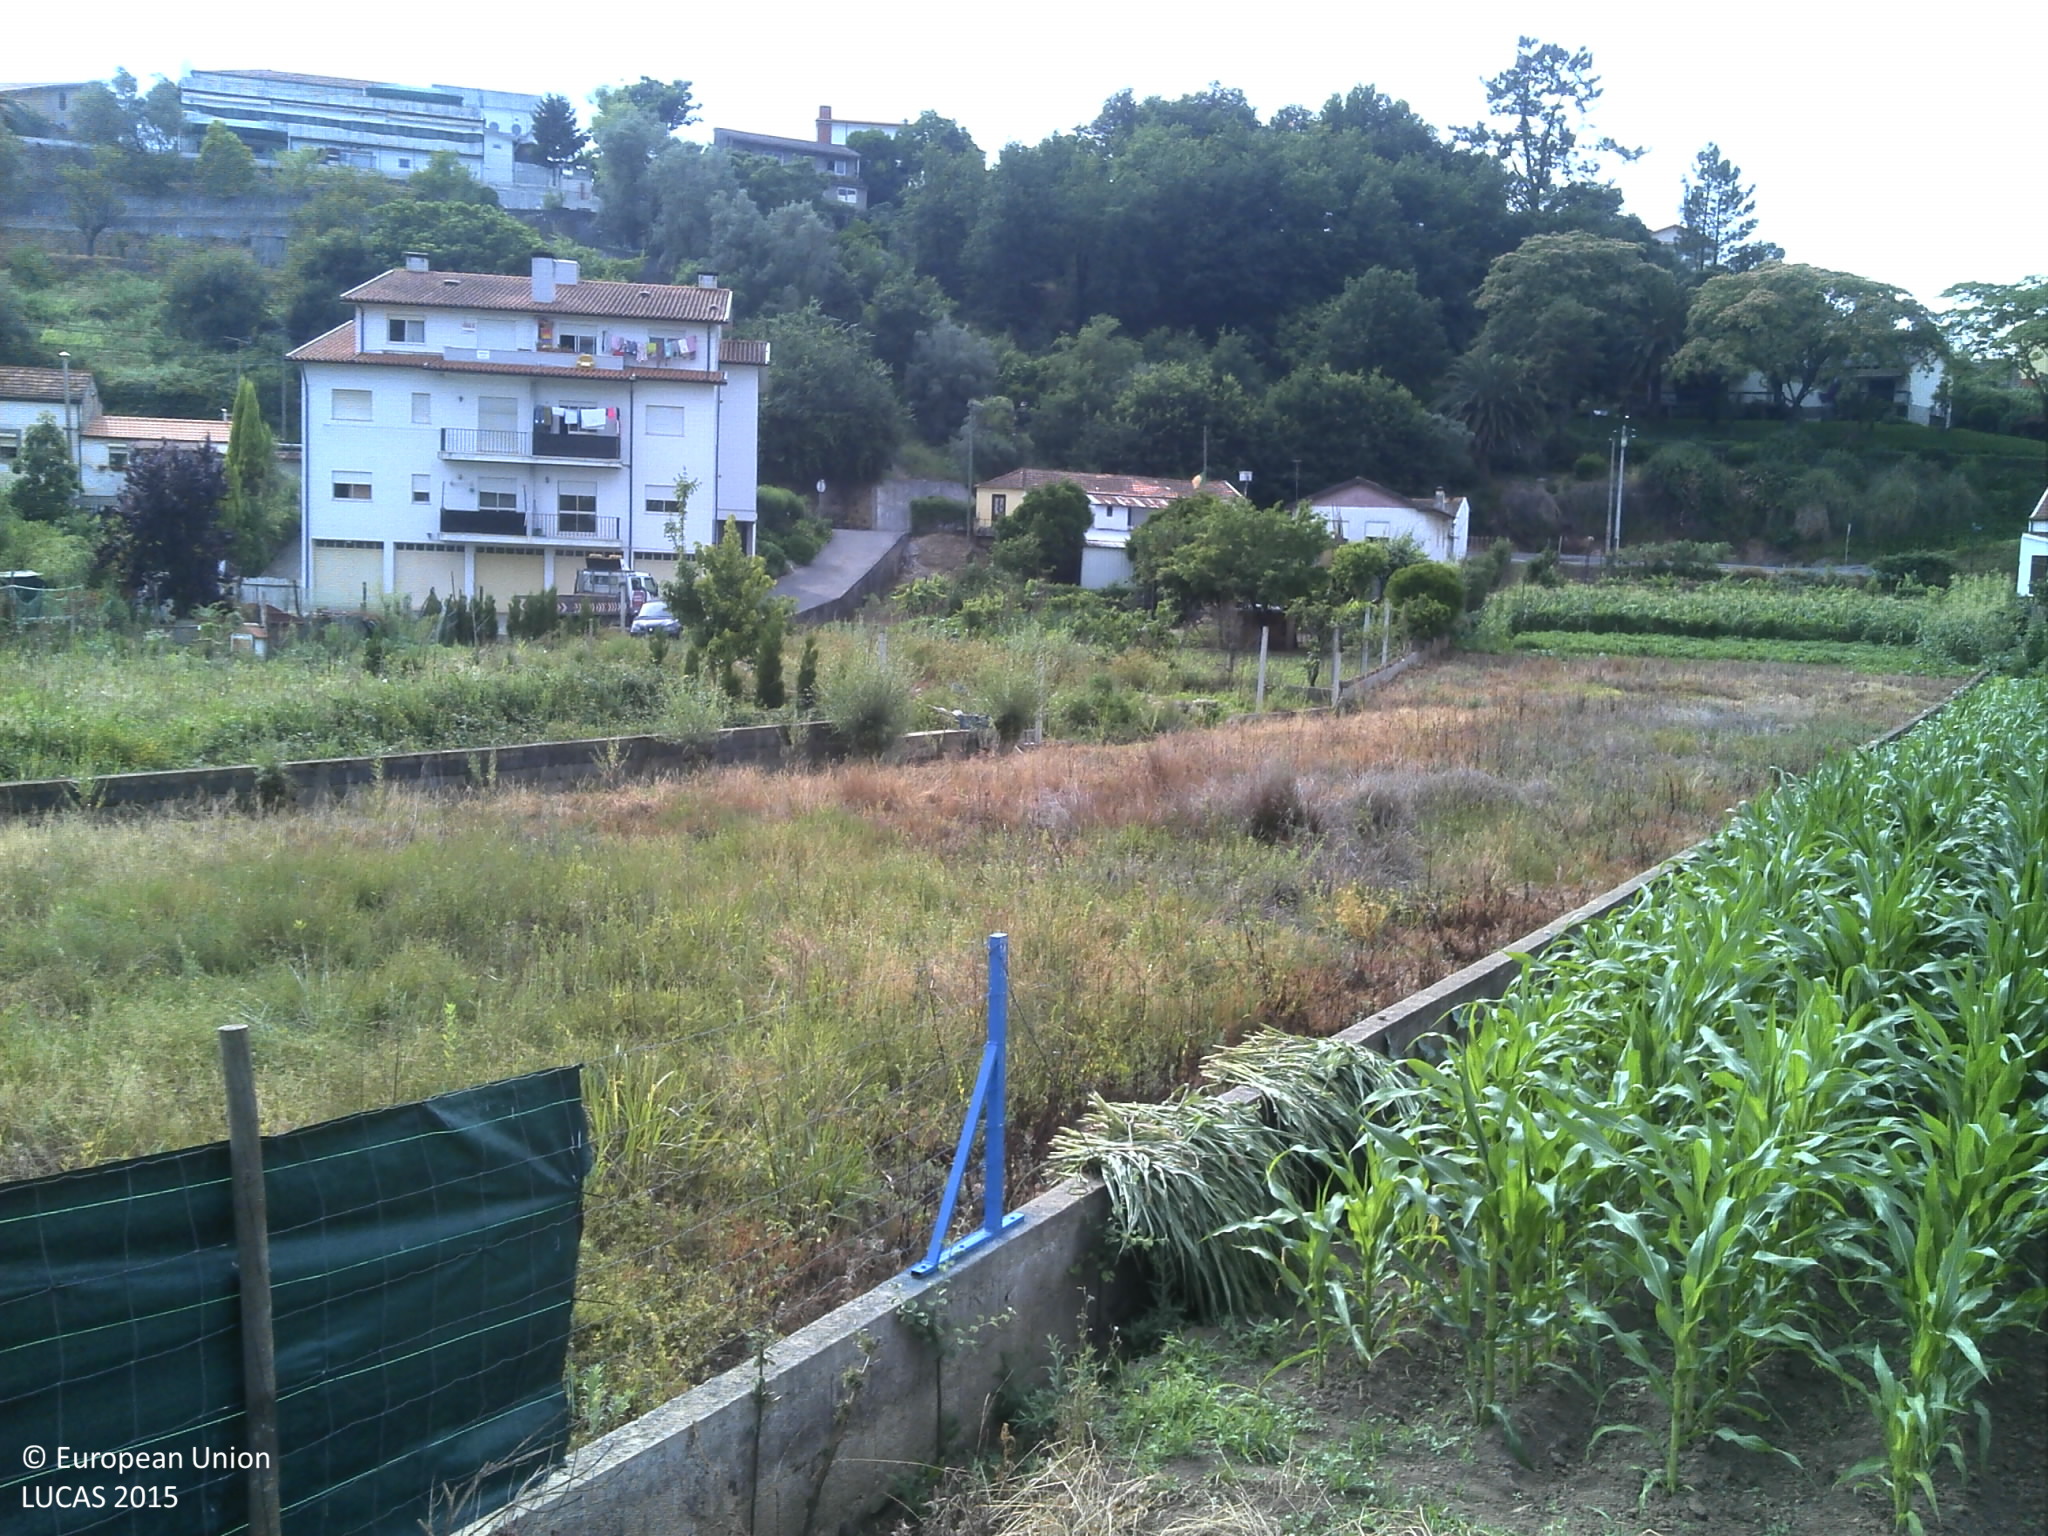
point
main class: Grassland
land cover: Spontaneously vegetated surfaces
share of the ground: > 75 %
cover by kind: herbaceous plants 80 %, unconsolidated bare surface 20 %
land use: Fallow land
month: June
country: PT
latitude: 40.5746
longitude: -8.4355
